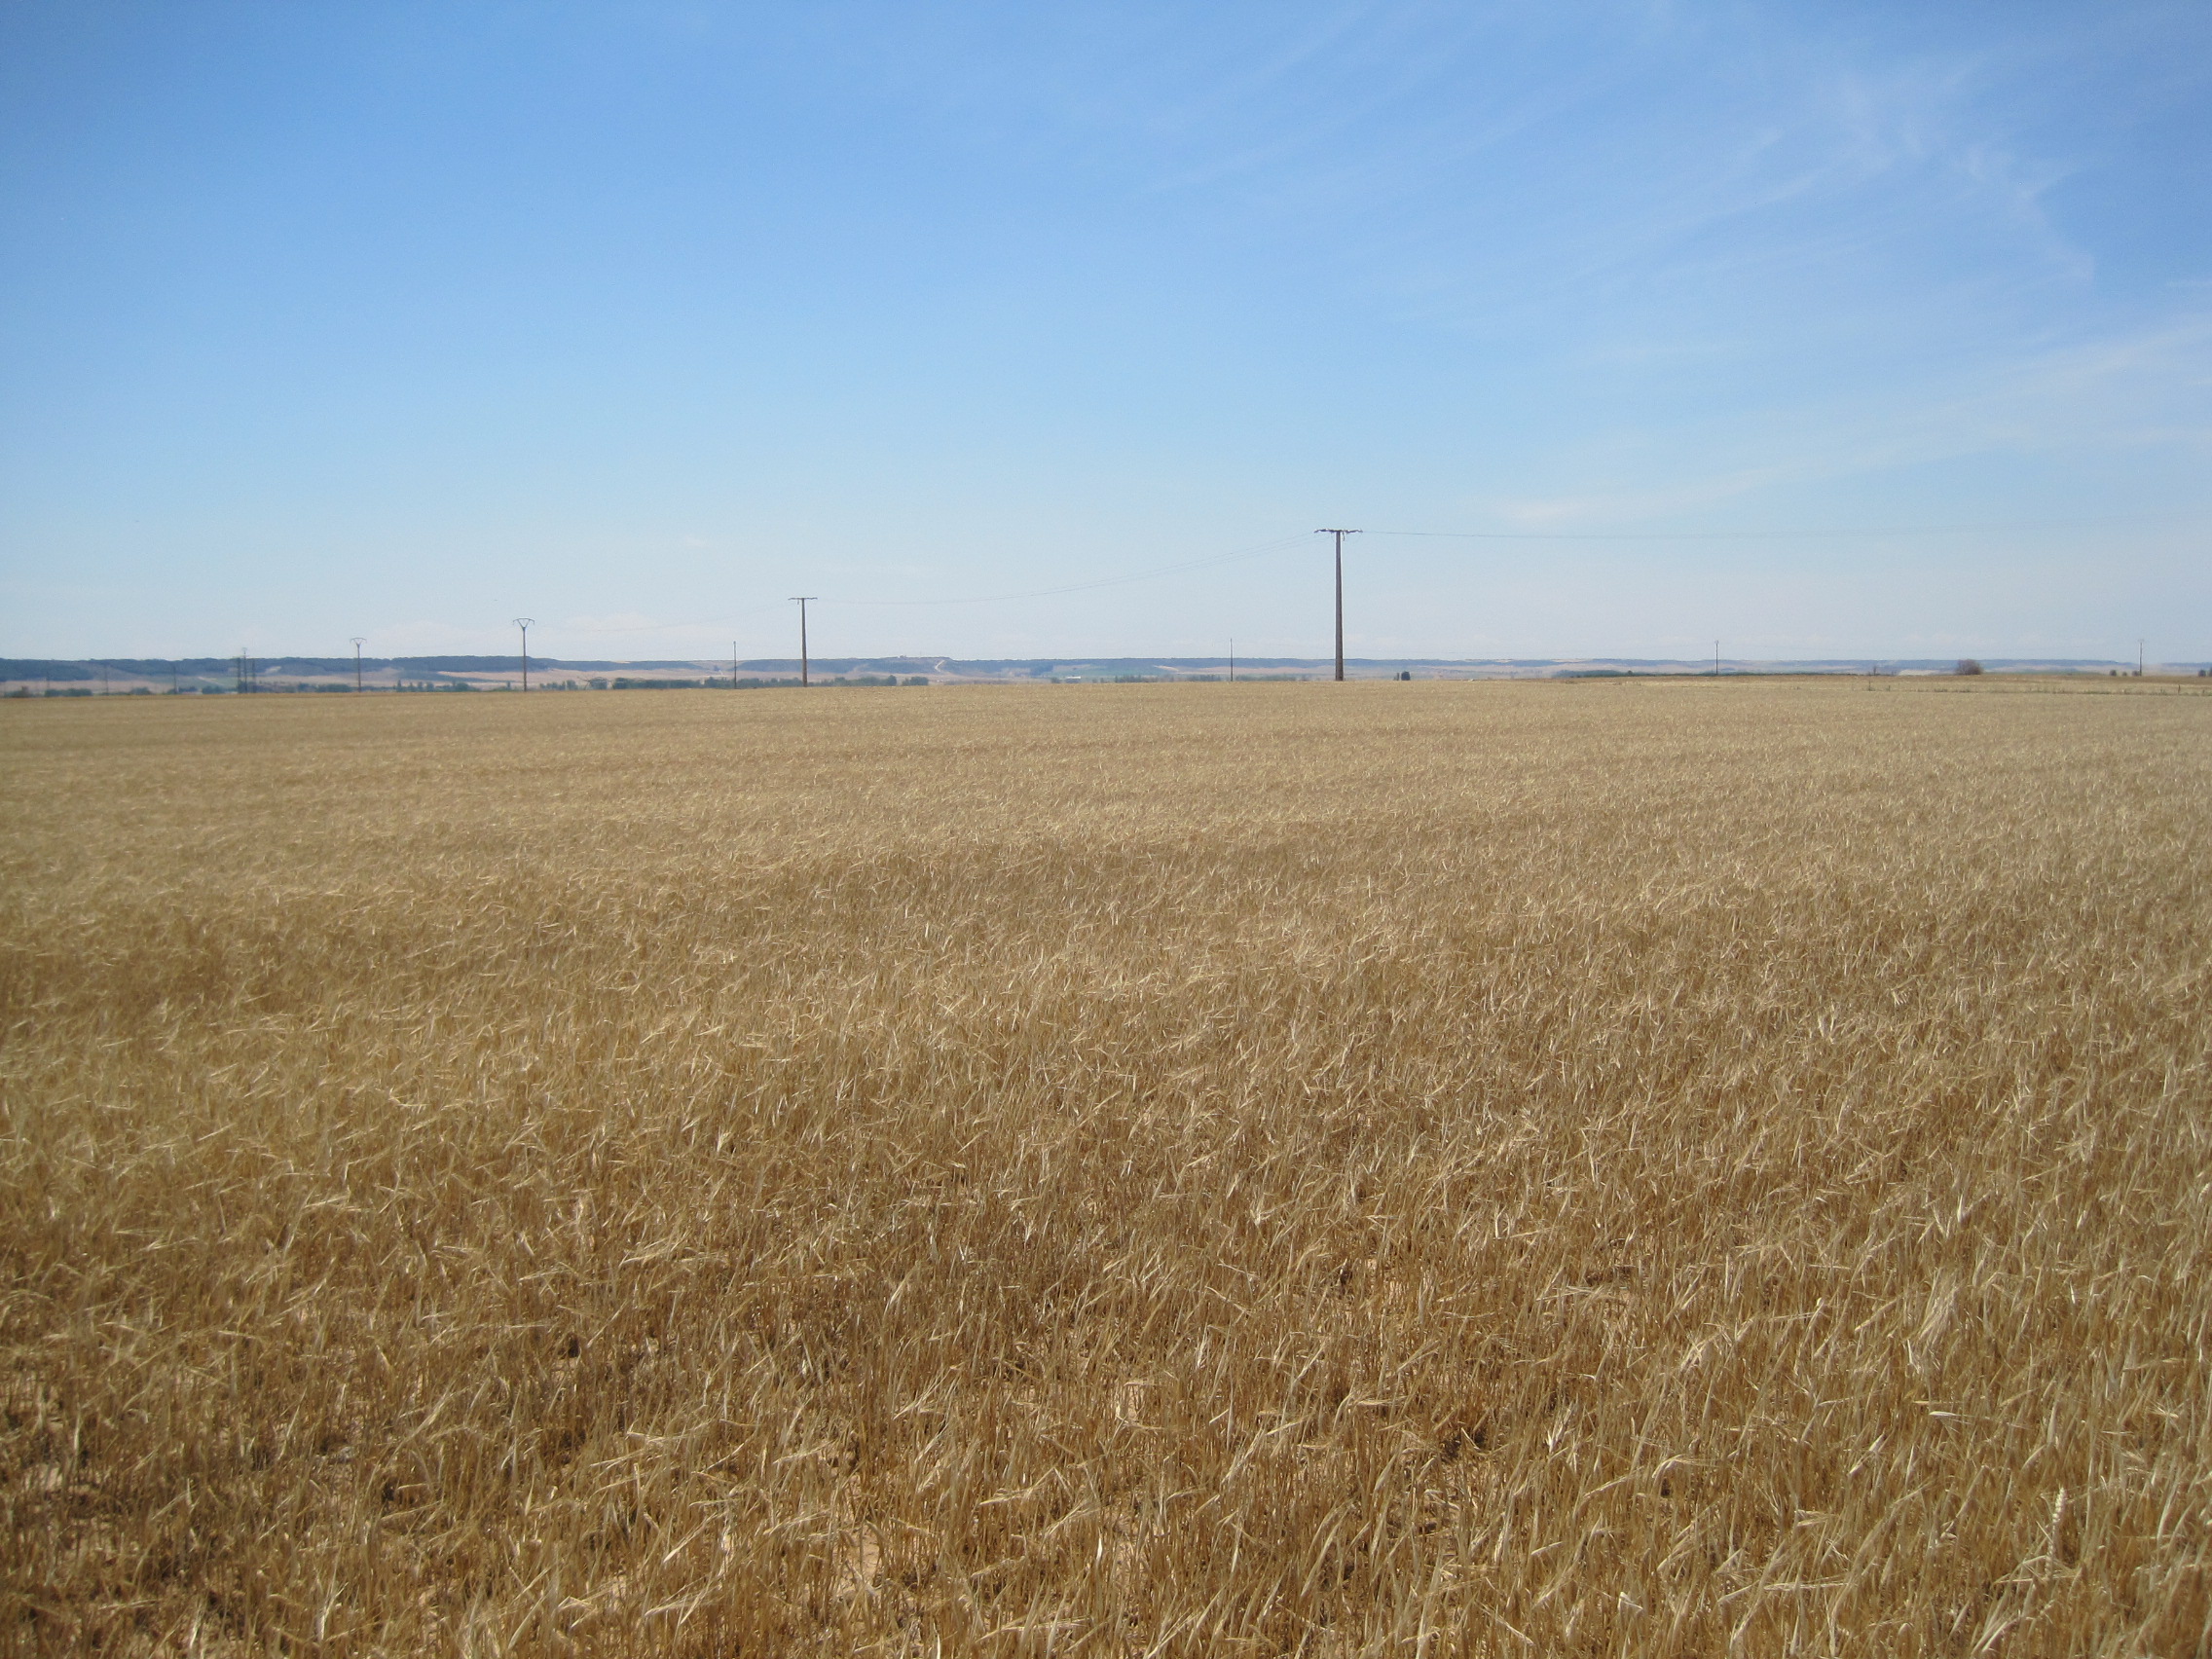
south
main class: Cropland
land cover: Barley
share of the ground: > 75 %
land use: Agriculture (excluding fallow land and kitchen gardens)
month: June
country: ES
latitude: 41.8270
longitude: -5.2149
